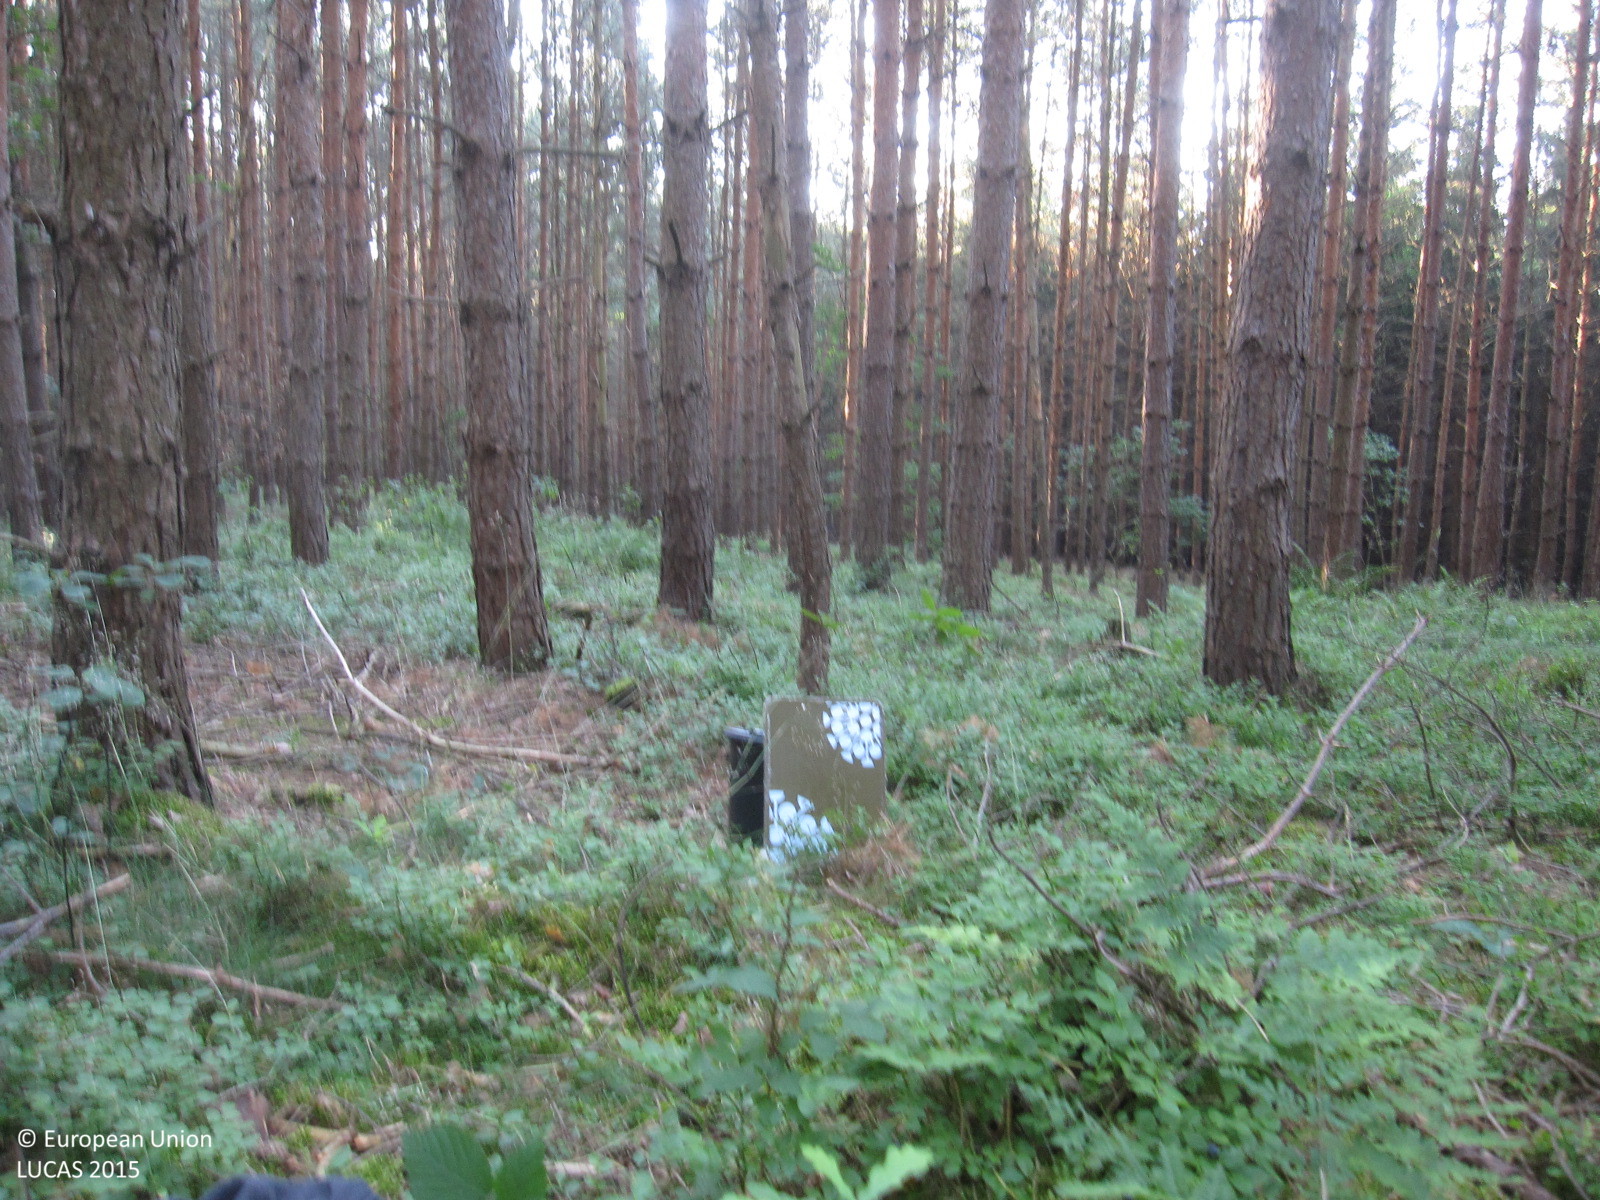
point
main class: Woodland
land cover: Pine dominated coniferous woodland
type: hemiboreal forest and nemoral coniferous forest and mixed broadleaved-coniferous forest
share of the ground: > 75 %
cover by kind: coniferous forest trees 90 %, herbaceous plants 5 %, unconsolidated bare surface 5 %
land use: Forestry
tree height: > 5 m
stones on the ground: 25 - 50 %
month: July
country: DE
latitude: 50.8681
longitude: 12.0032
